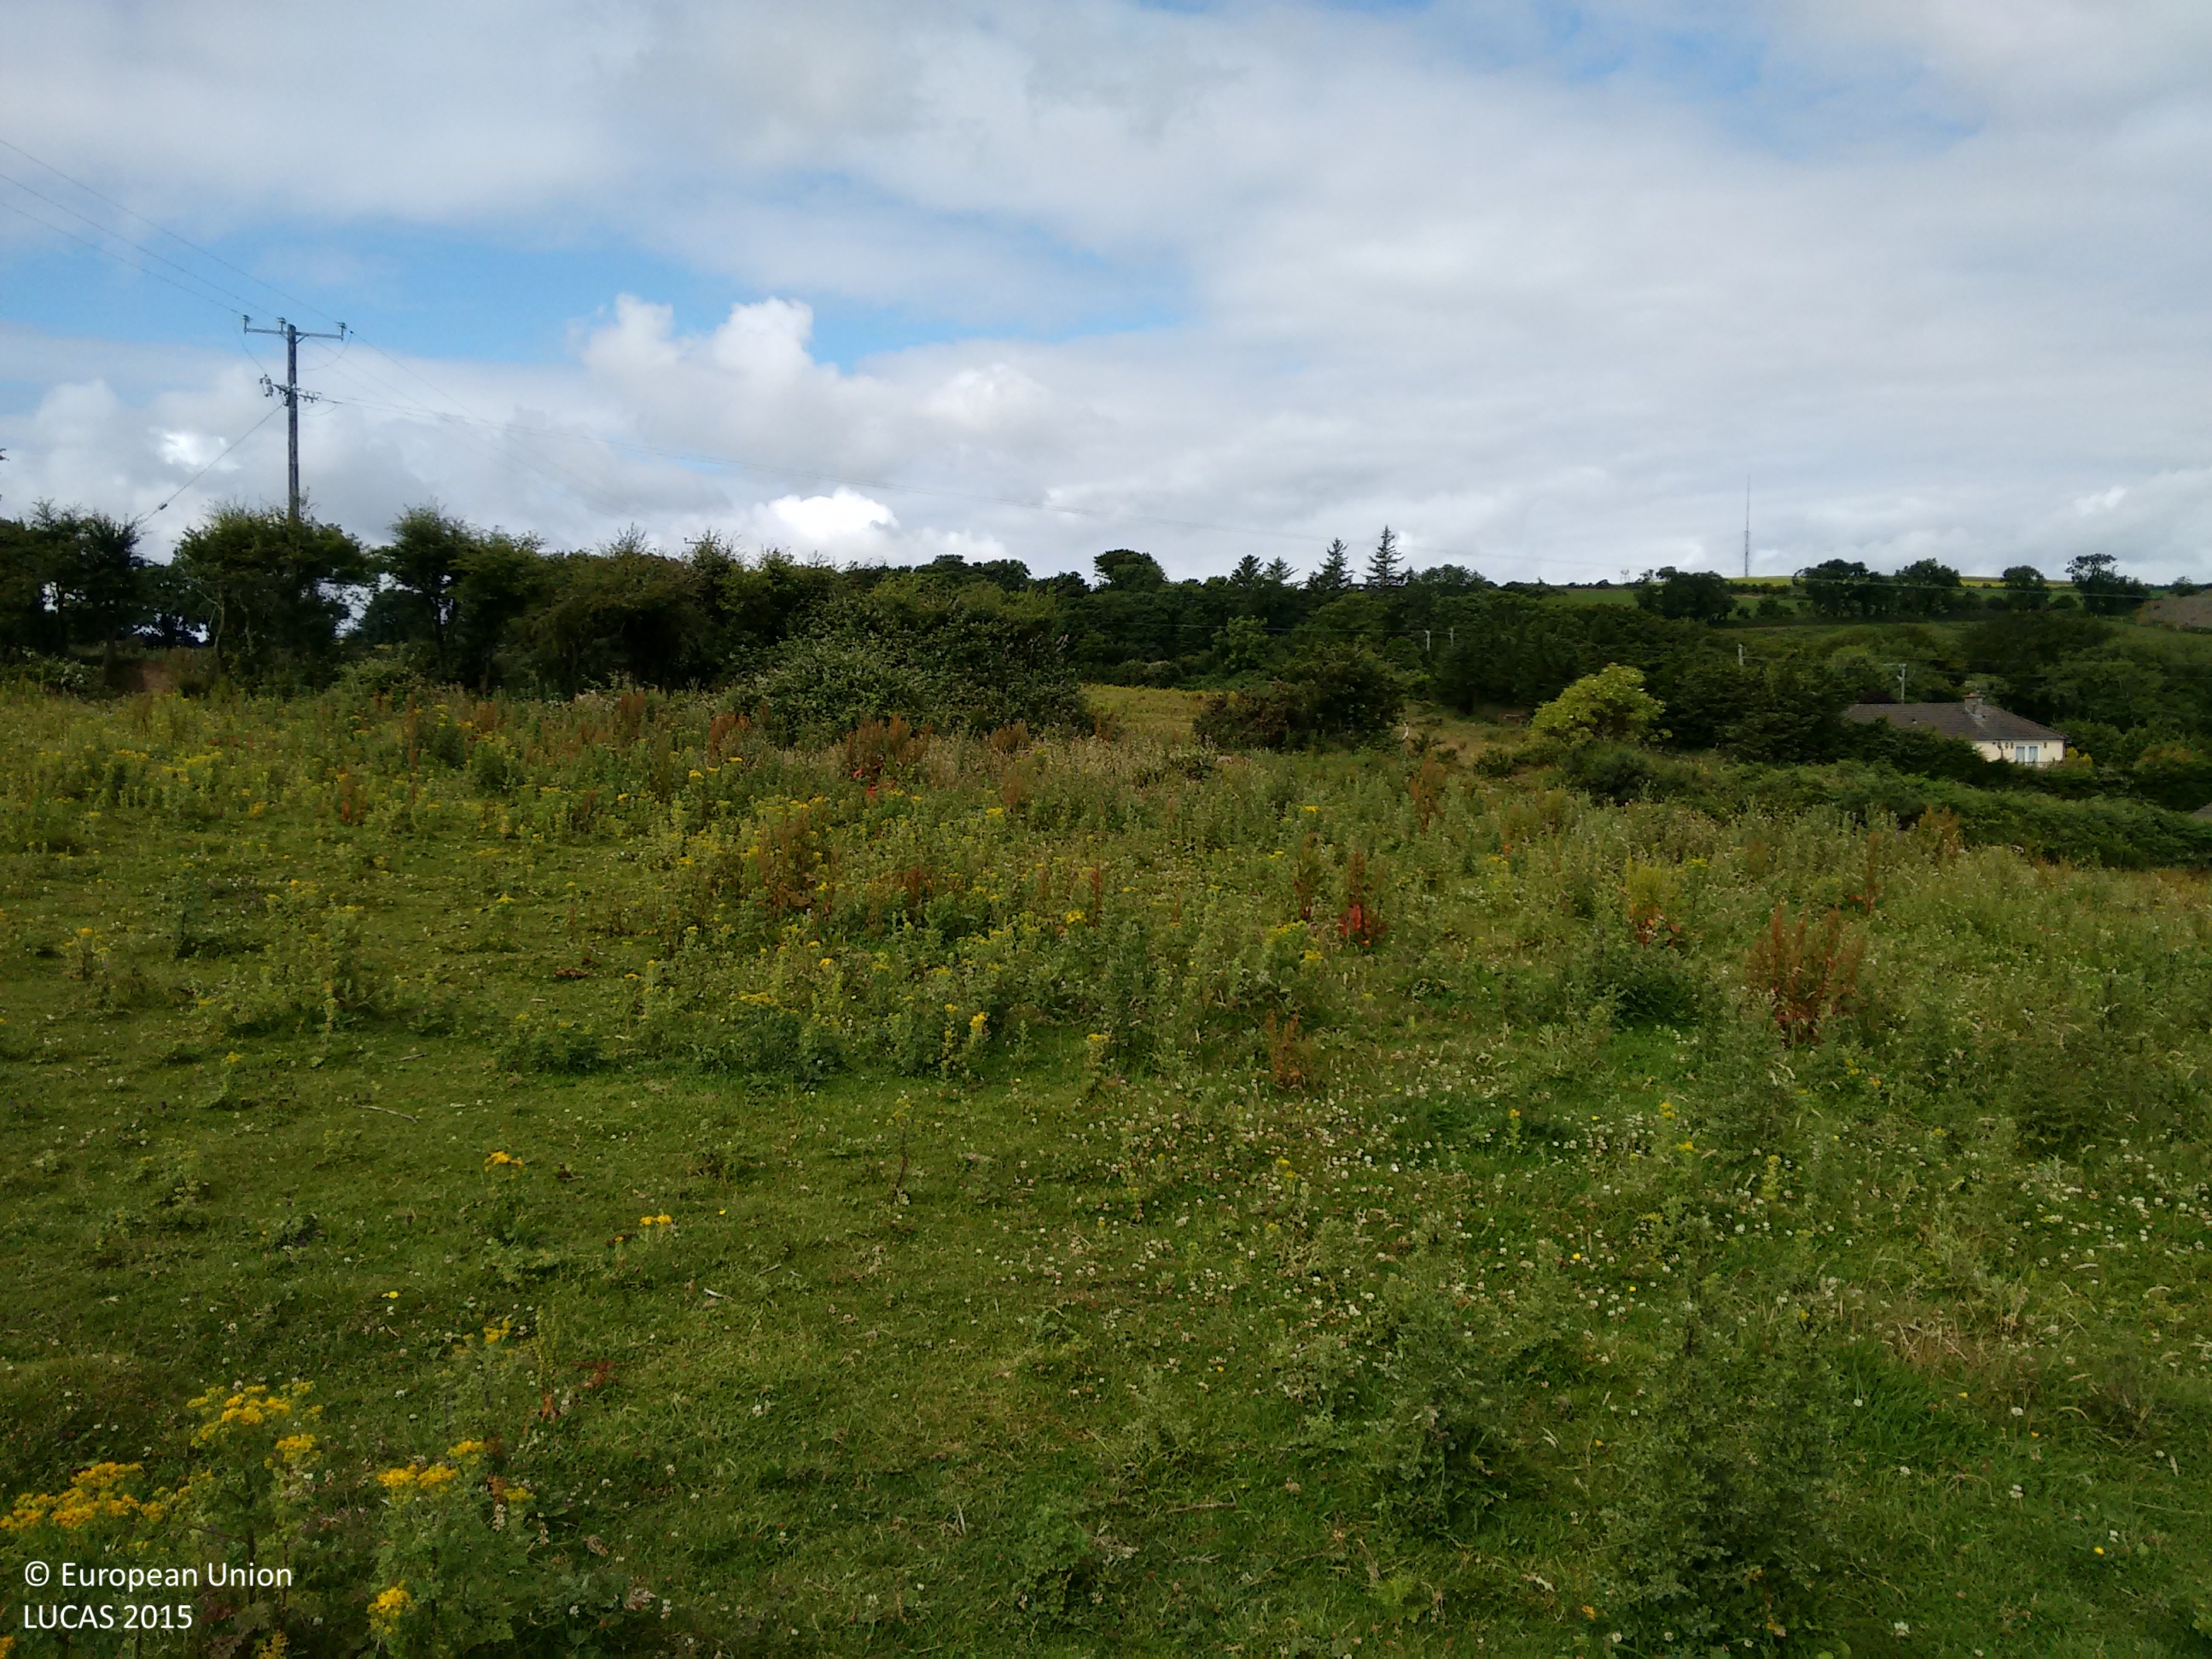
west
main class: Grassland
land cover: Grassland without tree/shrub cover
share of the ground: > 75 %
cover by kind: herbaceous plants 100 %
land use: Agriculture (excluding fallow land and kitchen gardens)
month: July
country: IE
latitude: 52.9662
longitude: -6.0302
